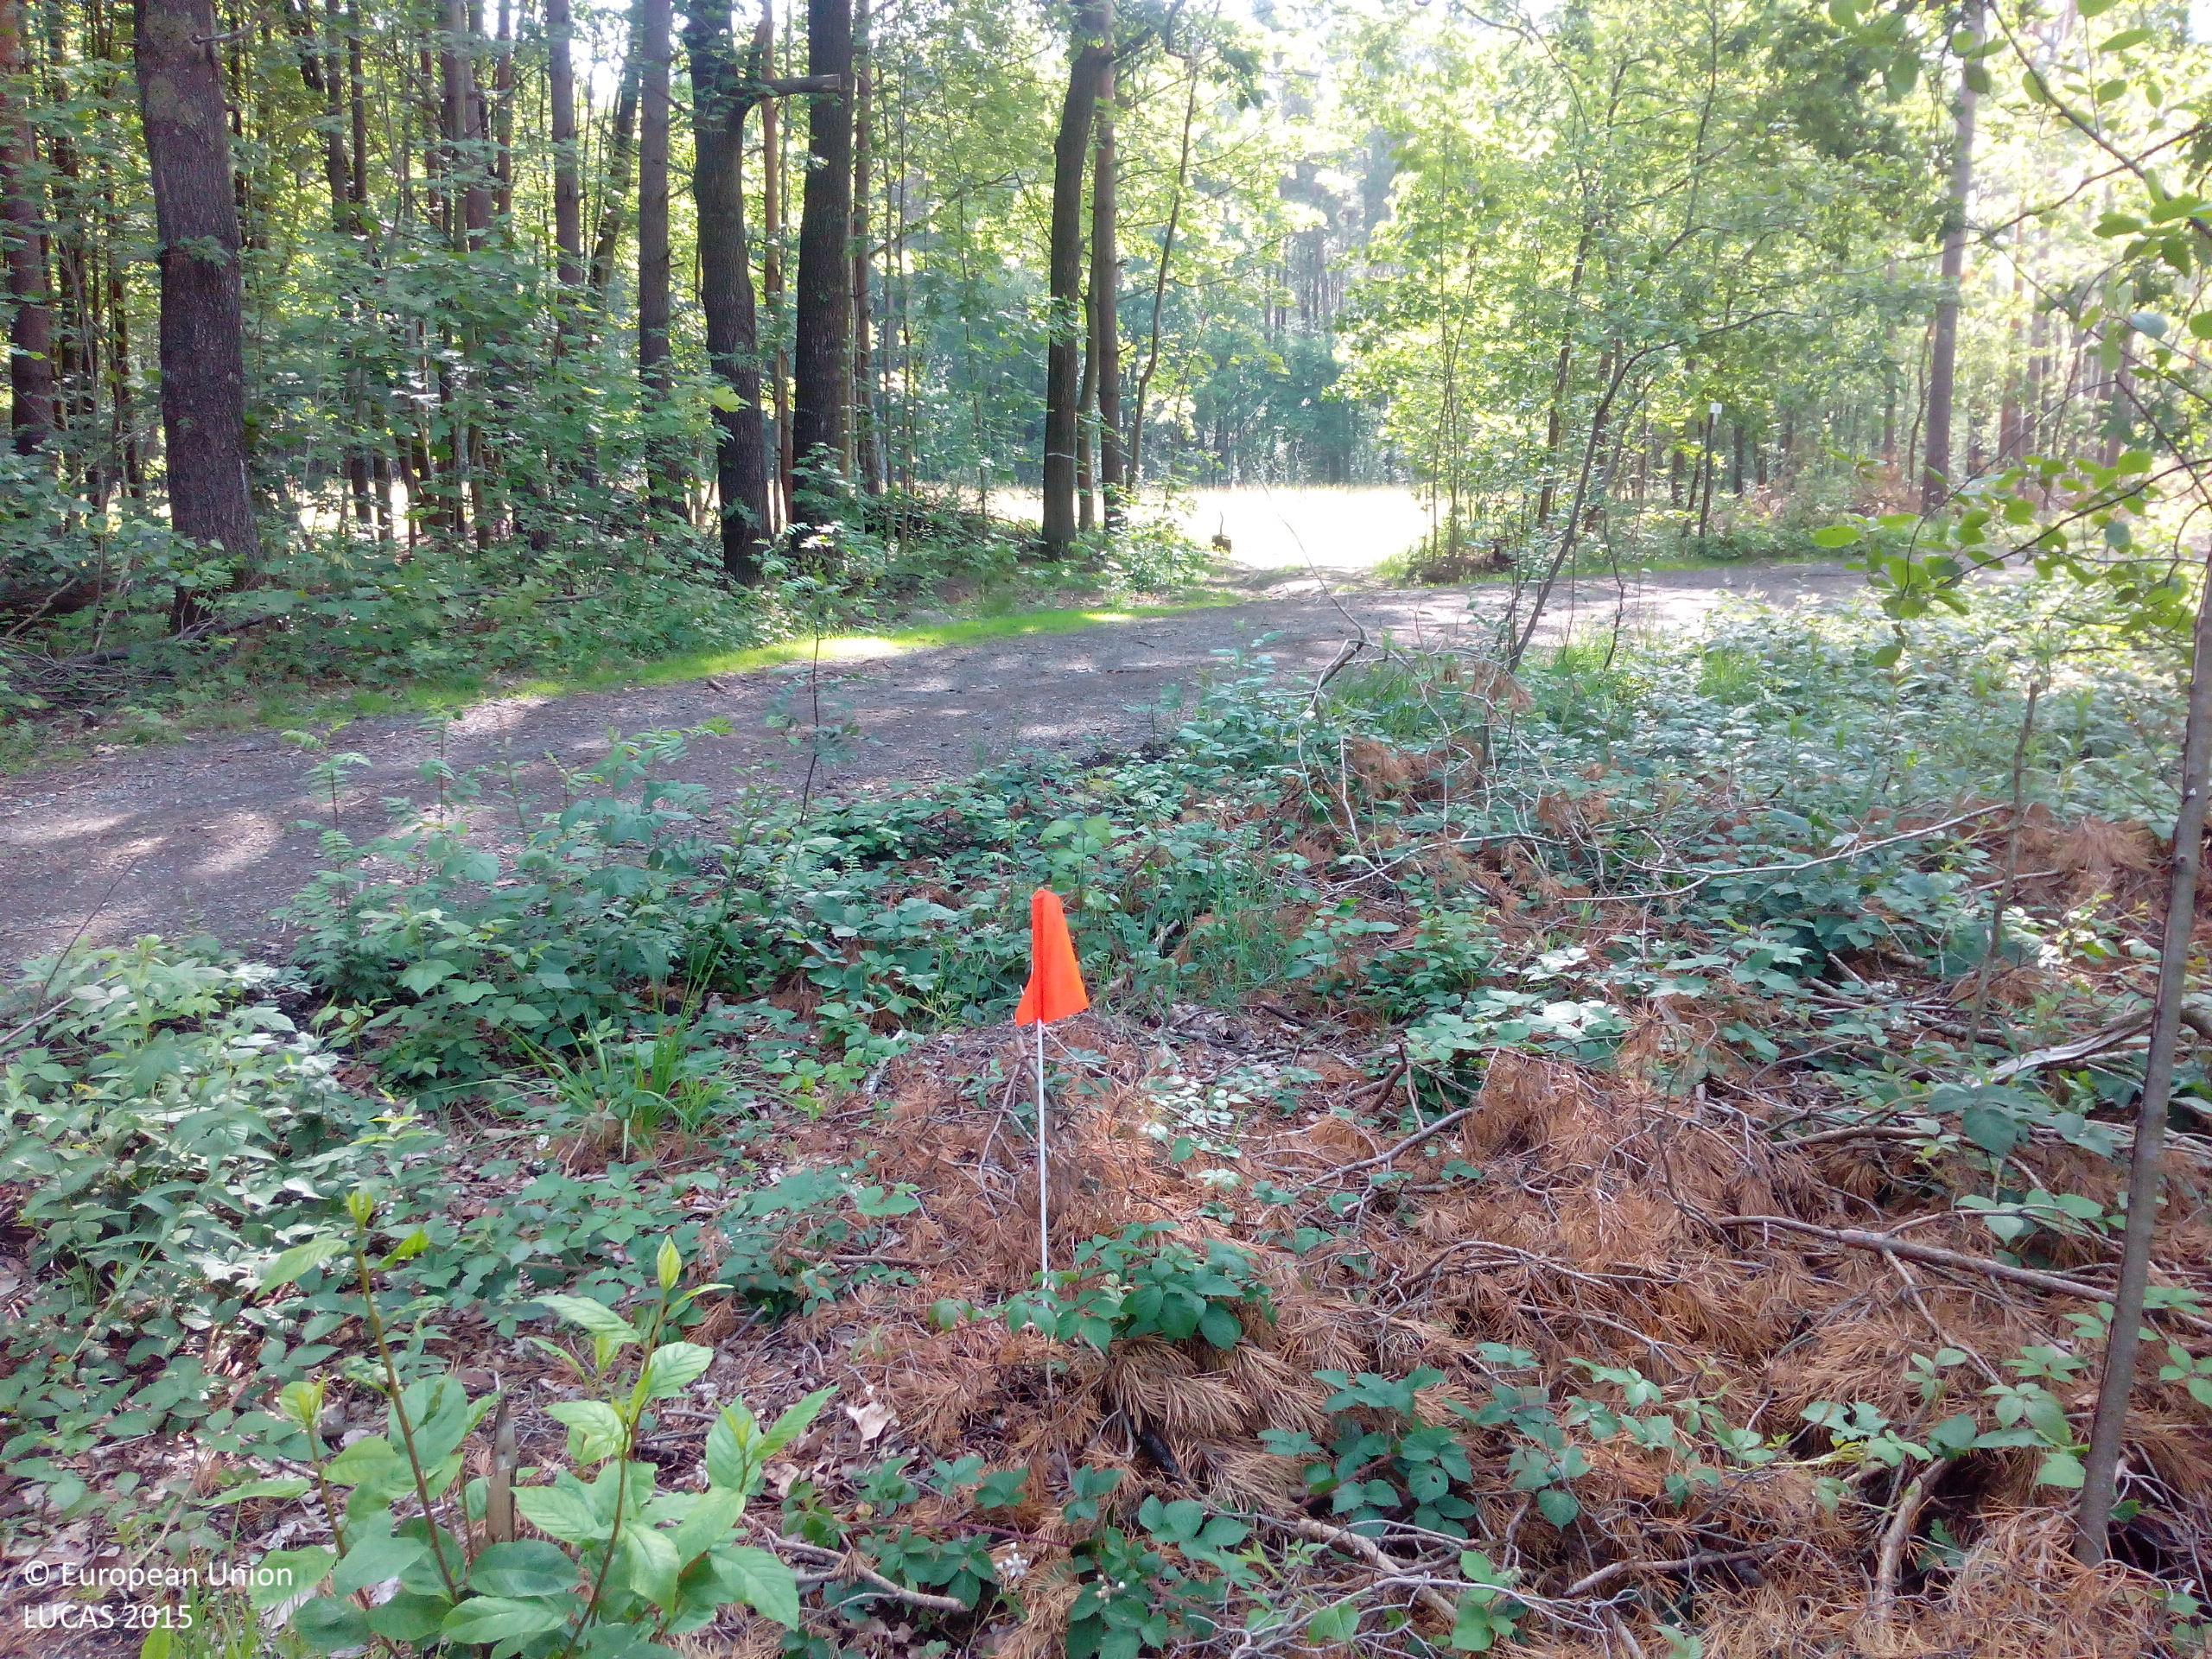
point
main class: Woodland
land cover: Pine dominated mixed woodland
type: hemiboreal forest and nemoral coniferous forest and mixed broadleaved-coniferous forest
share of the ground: 25 - 50 %
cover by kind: shrubs 35 %, coniferous forest trees 25 %, broadleaved forest trees 20 %, unconsolidated bare surface 20 %
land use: Forestry
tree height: > 5 m
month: June
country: DE
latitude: 51.2842
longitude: 14.0013
